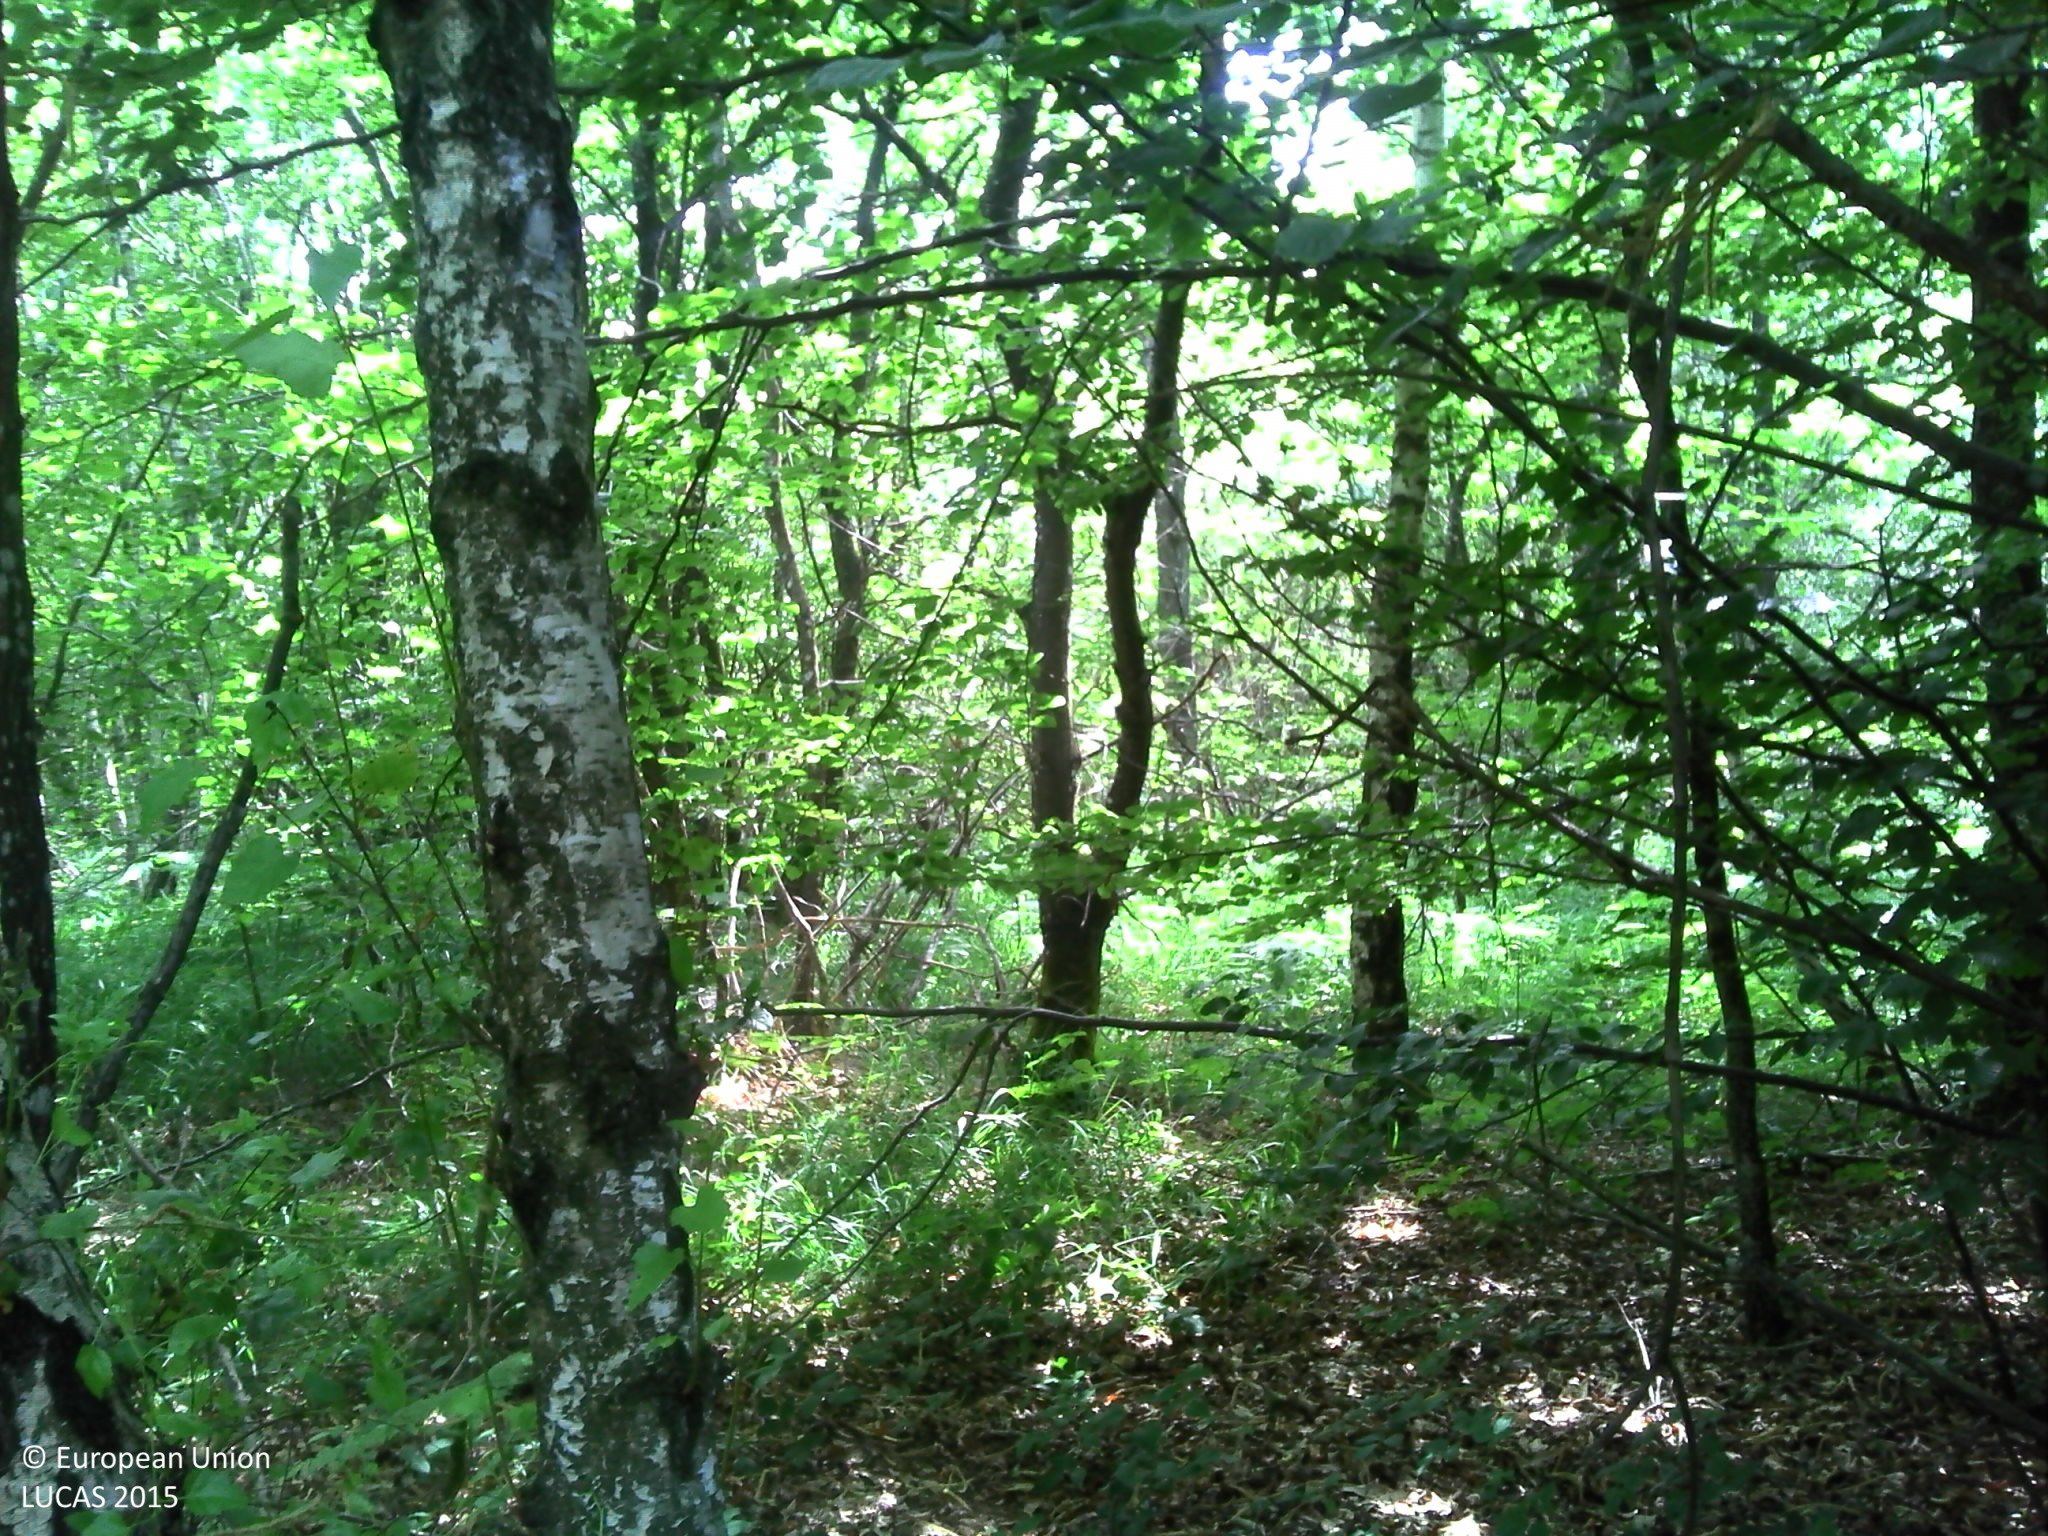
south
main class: Woodland
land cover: Broadleaved woodland
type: acidophilous oak and oak-birch forest
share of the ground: > 75 %
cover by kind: broadleaved forest trees 80 %, herbaceous plants 10 %, consolidated bare surface 10 %
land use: Forestry
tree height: > 5 m
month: July
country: FR
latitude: 45.2903
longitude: 5.2746
